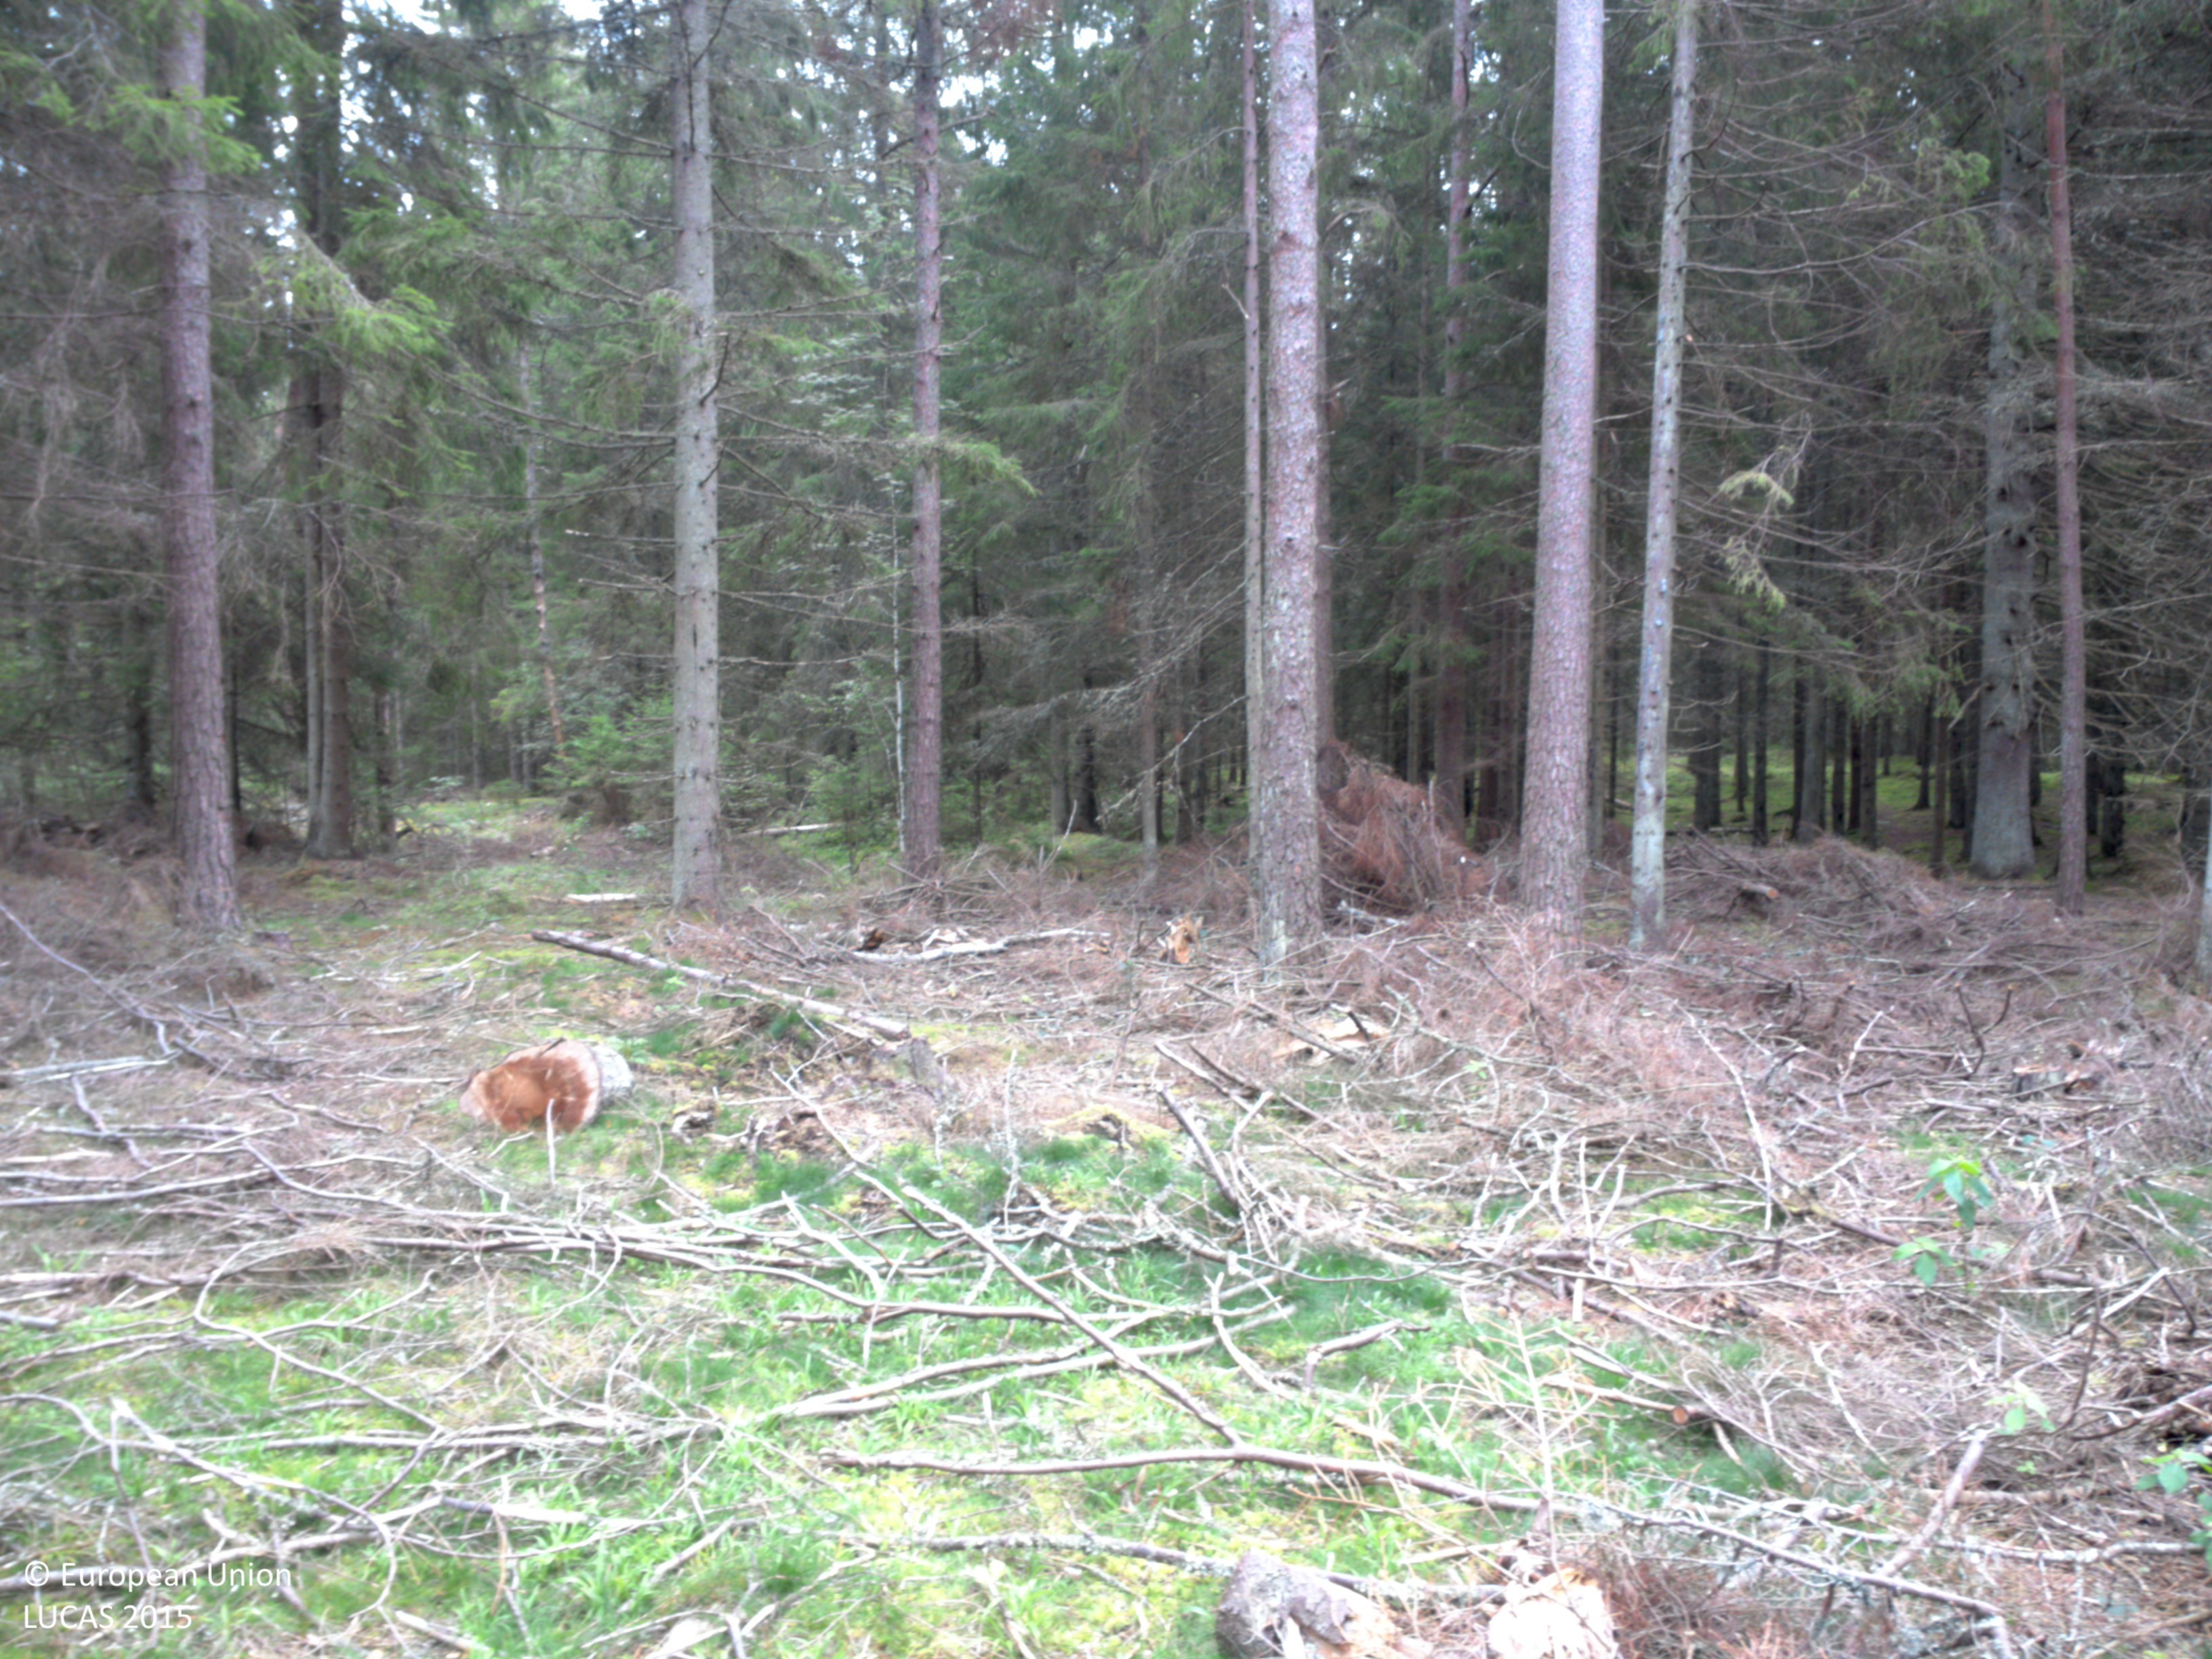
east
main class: Woodland
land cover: Spruce dominated coniferous woodland
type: boreal forest
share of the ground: 50 - 75 %
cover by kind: herbaceous plants 60 %, coniferous forest trees 30 %, broadleaved forest trees 5 %, lichens and mosses 5 %
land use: Forestry
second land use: Sport
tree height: > 5 m
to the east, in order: Spruce dominated coniferous woodland; Pine dominated coniferous woodland; Spruce dominated coniferous woodland; Electric lines; Tracks; Spruce dominated coniferous woodland; Grassland with sparse tree/shrub cover; Grassland without tree/shrub cover; Pine dominated coniferous woodland; Ditches and canals; Pine dominated coniferous woodland
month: August
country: SE
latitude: 58.2539
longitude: 12.2961
